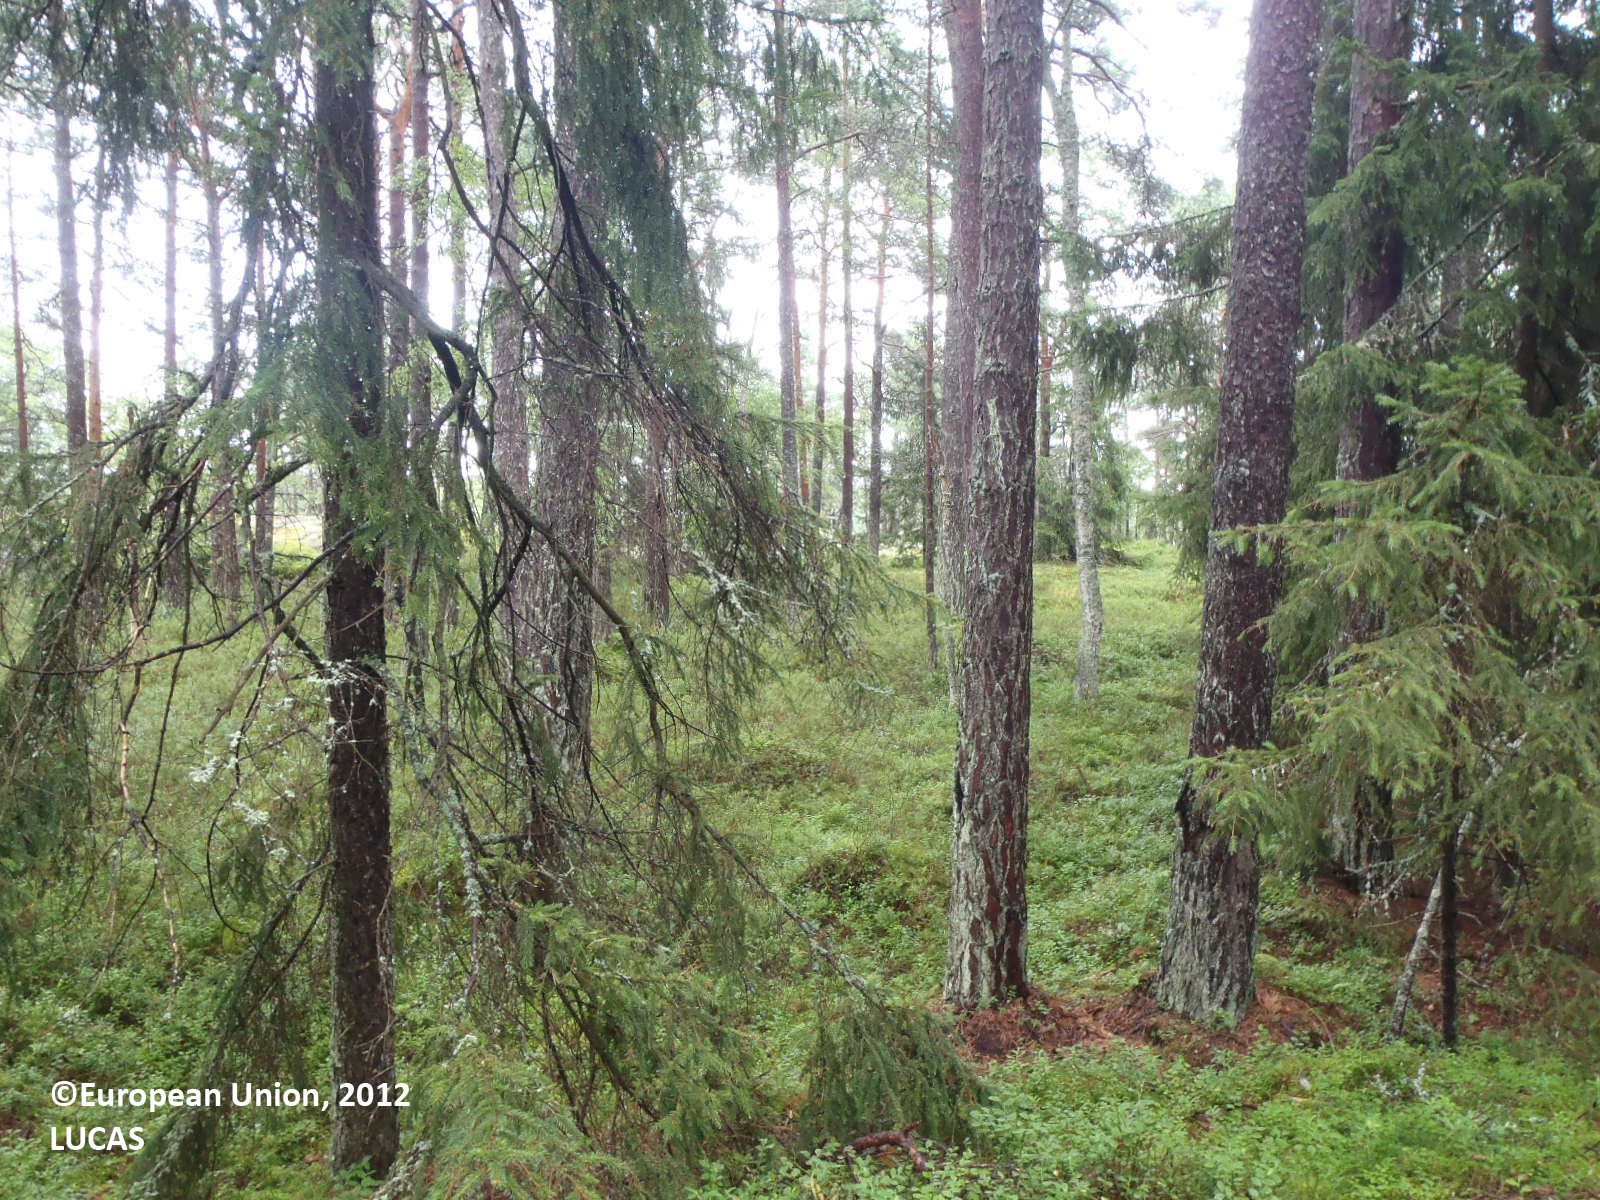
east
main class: Woodland
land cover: Pine dominated coniferous woodland
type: boreal forest
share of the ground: 50 - 75 %
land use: Forestry
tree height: > 5 m
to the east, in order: Pine dominated coniferous woodland; Grass margins; Ditches and canals; Grass margins; Oats; Grass margins; Ditches and canals; Grass margins; Common wheat
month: August
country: FI
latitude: 60.1157
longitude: 19.9934
